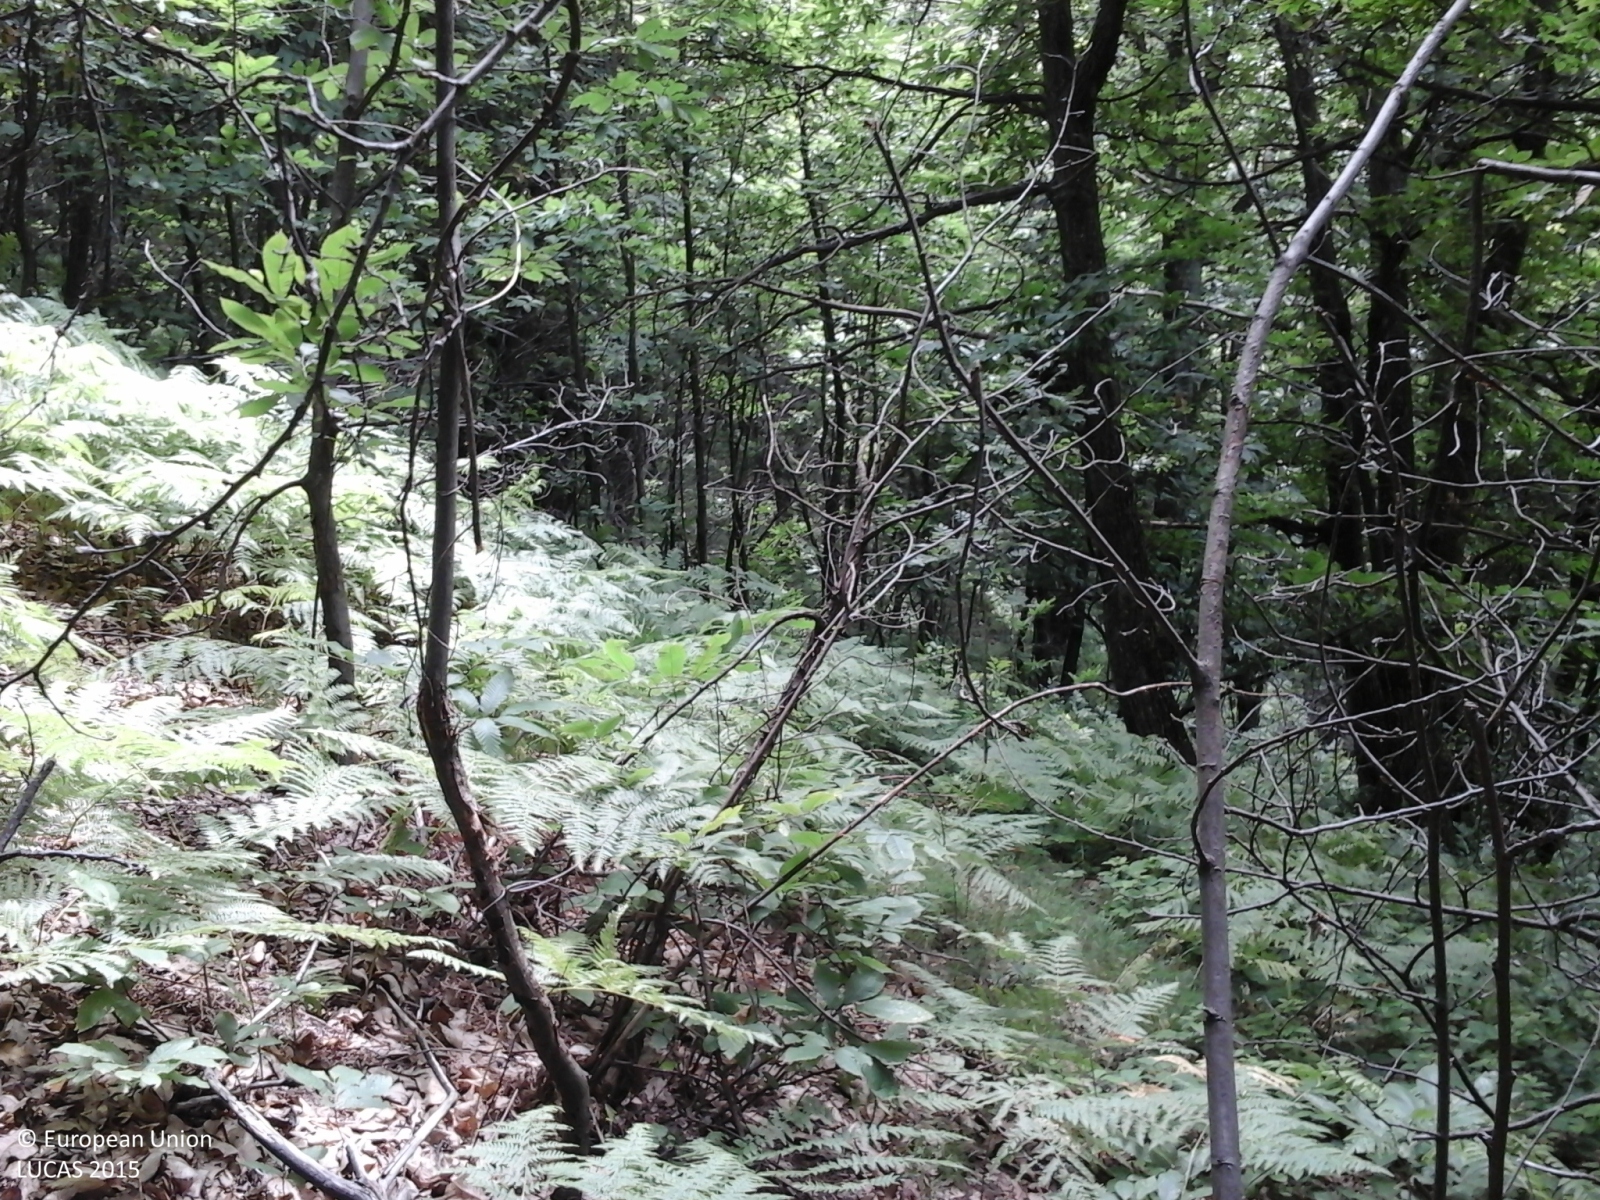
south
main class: Woodland
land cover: Broadleaved woodland
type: thermophilous deciduous forest
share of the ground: > 75 %
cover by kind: broadleaved forest trees 100 %
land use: Forestry
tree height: > 5 m
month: June
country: IT
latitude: 44.2914
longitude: 7.8116
